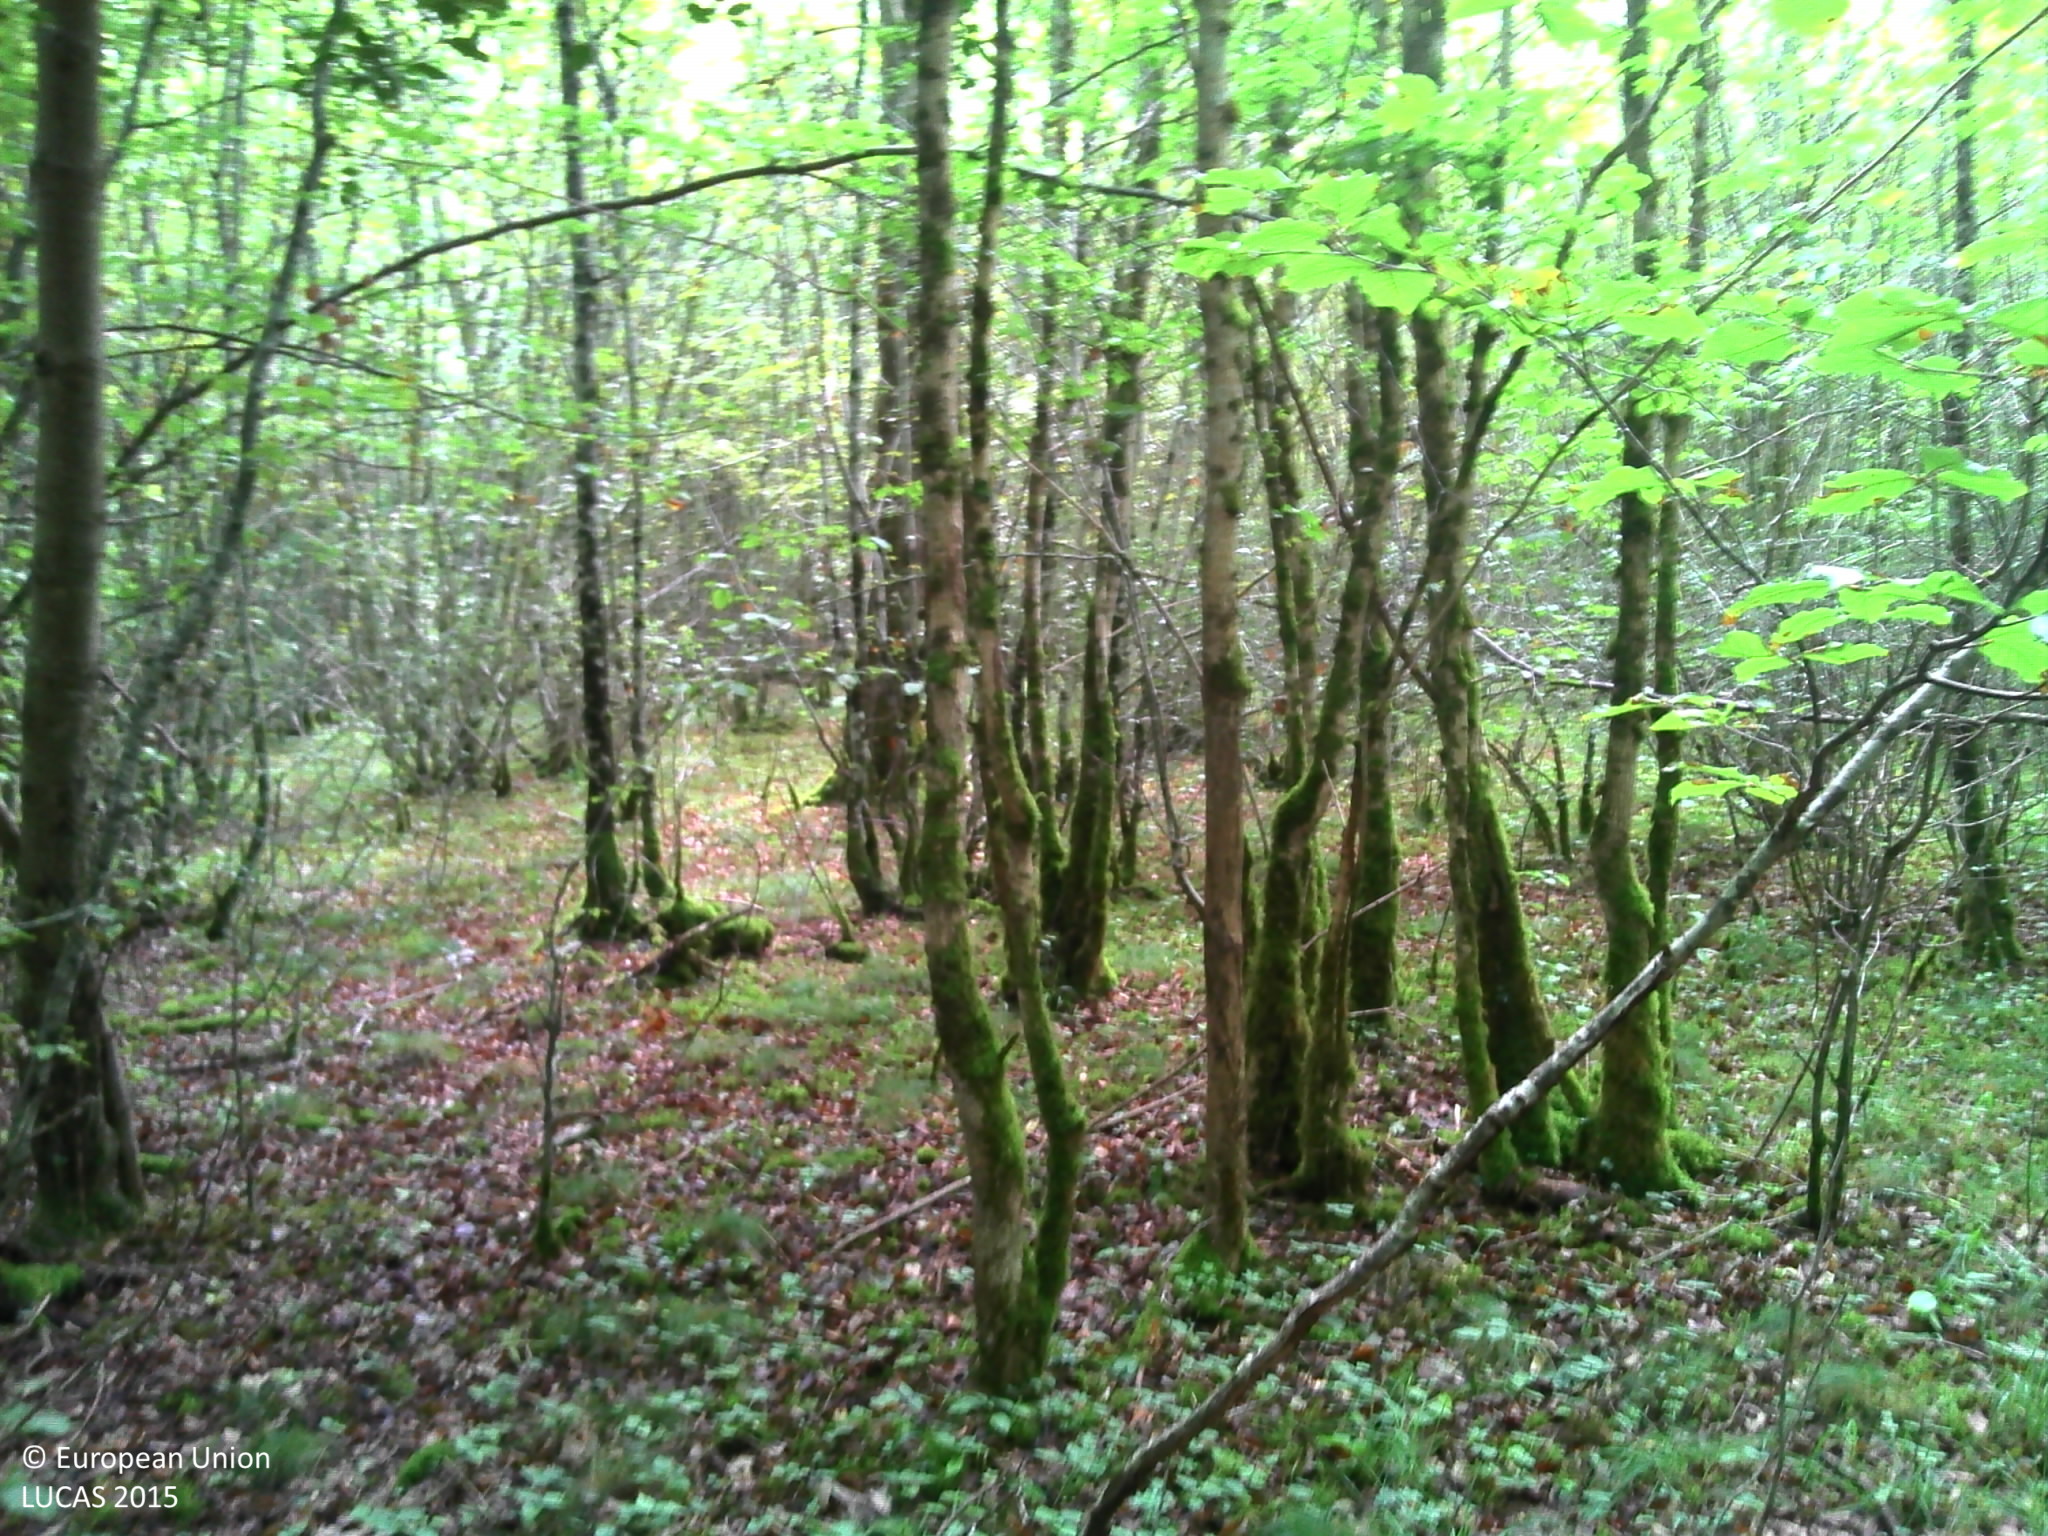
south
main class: Woodland
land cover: Broadleaved woodland
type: mesophytic deciduous forest
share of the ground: > 75 %
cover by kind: broadleaved forest trees 100 %
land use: Forestry
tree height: > 5 m
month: August
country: FR
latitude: 47.3625
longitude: 4.8229
